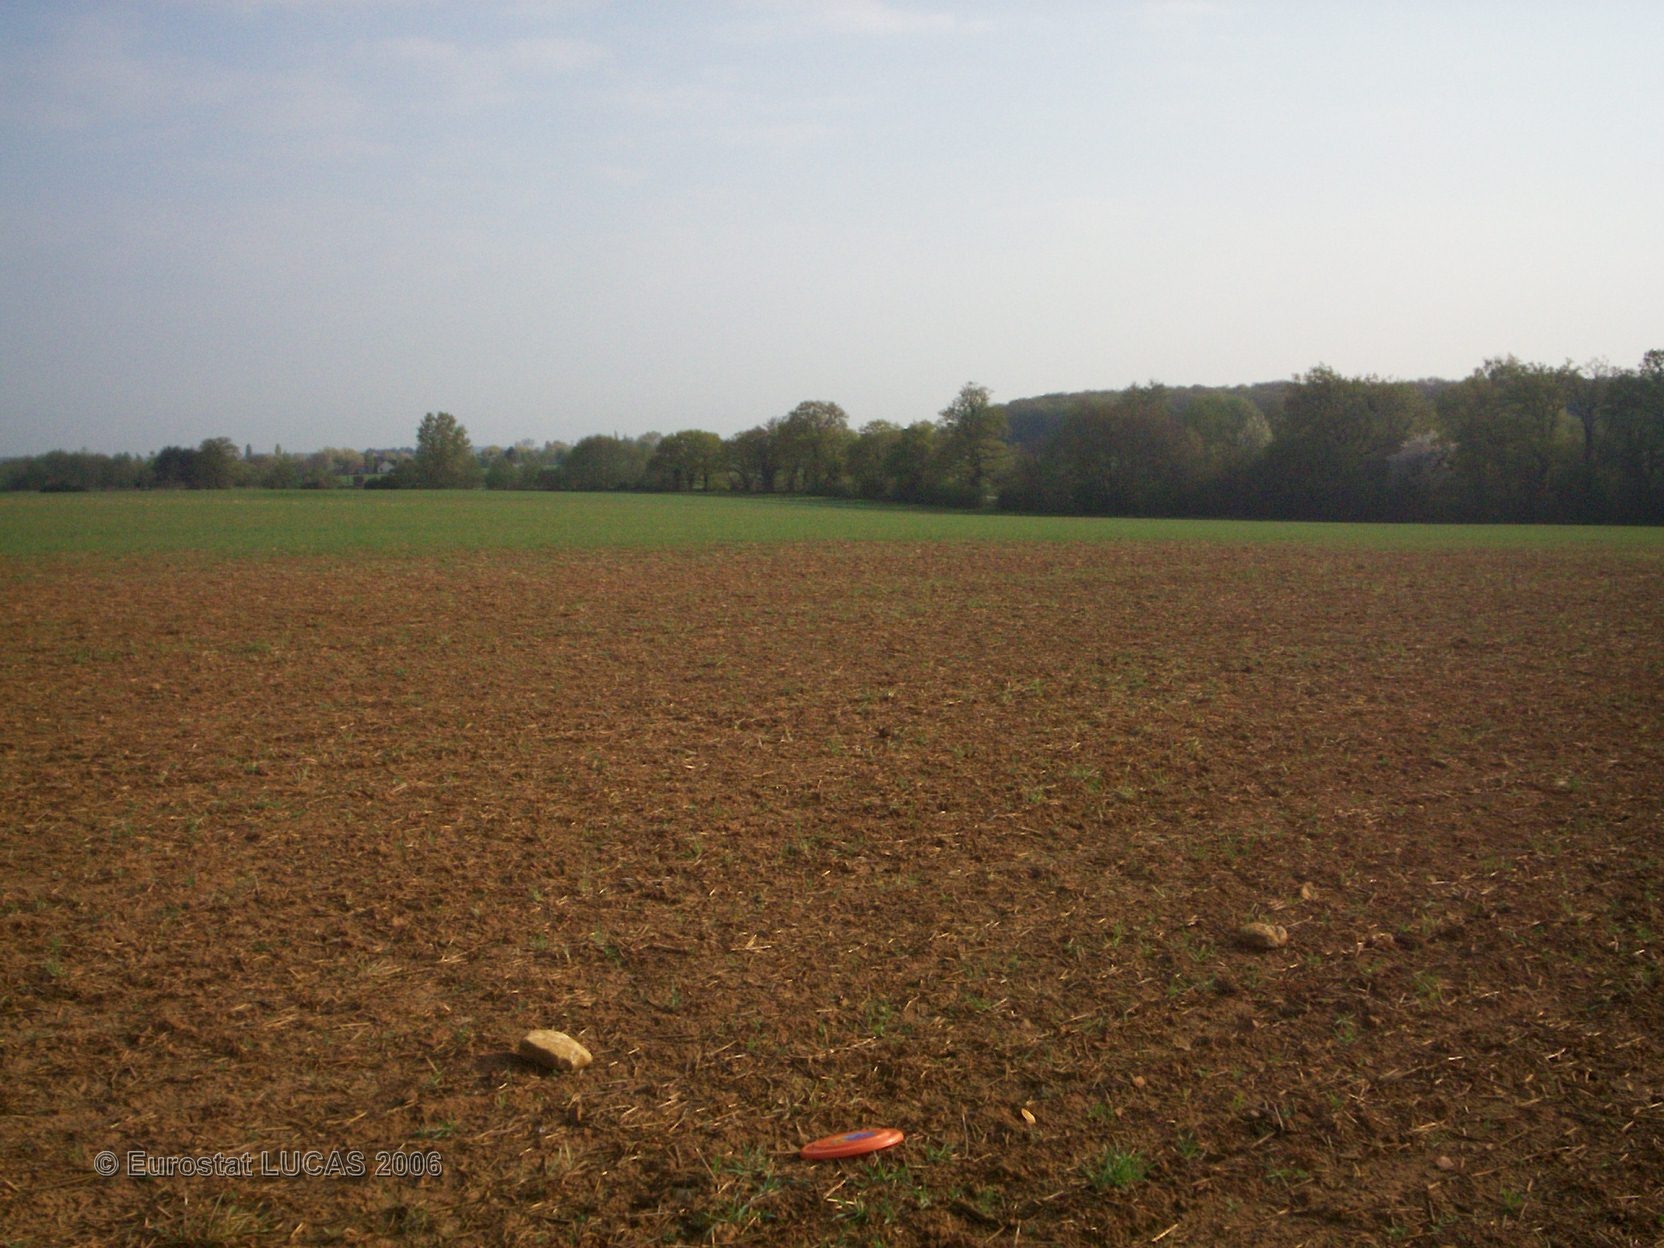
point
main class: Cropland
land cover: Barley
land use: Agriculture (excluding fallow land and kitchen gardens)
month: April
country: FR
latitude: 47.1923
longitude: 3.0662
